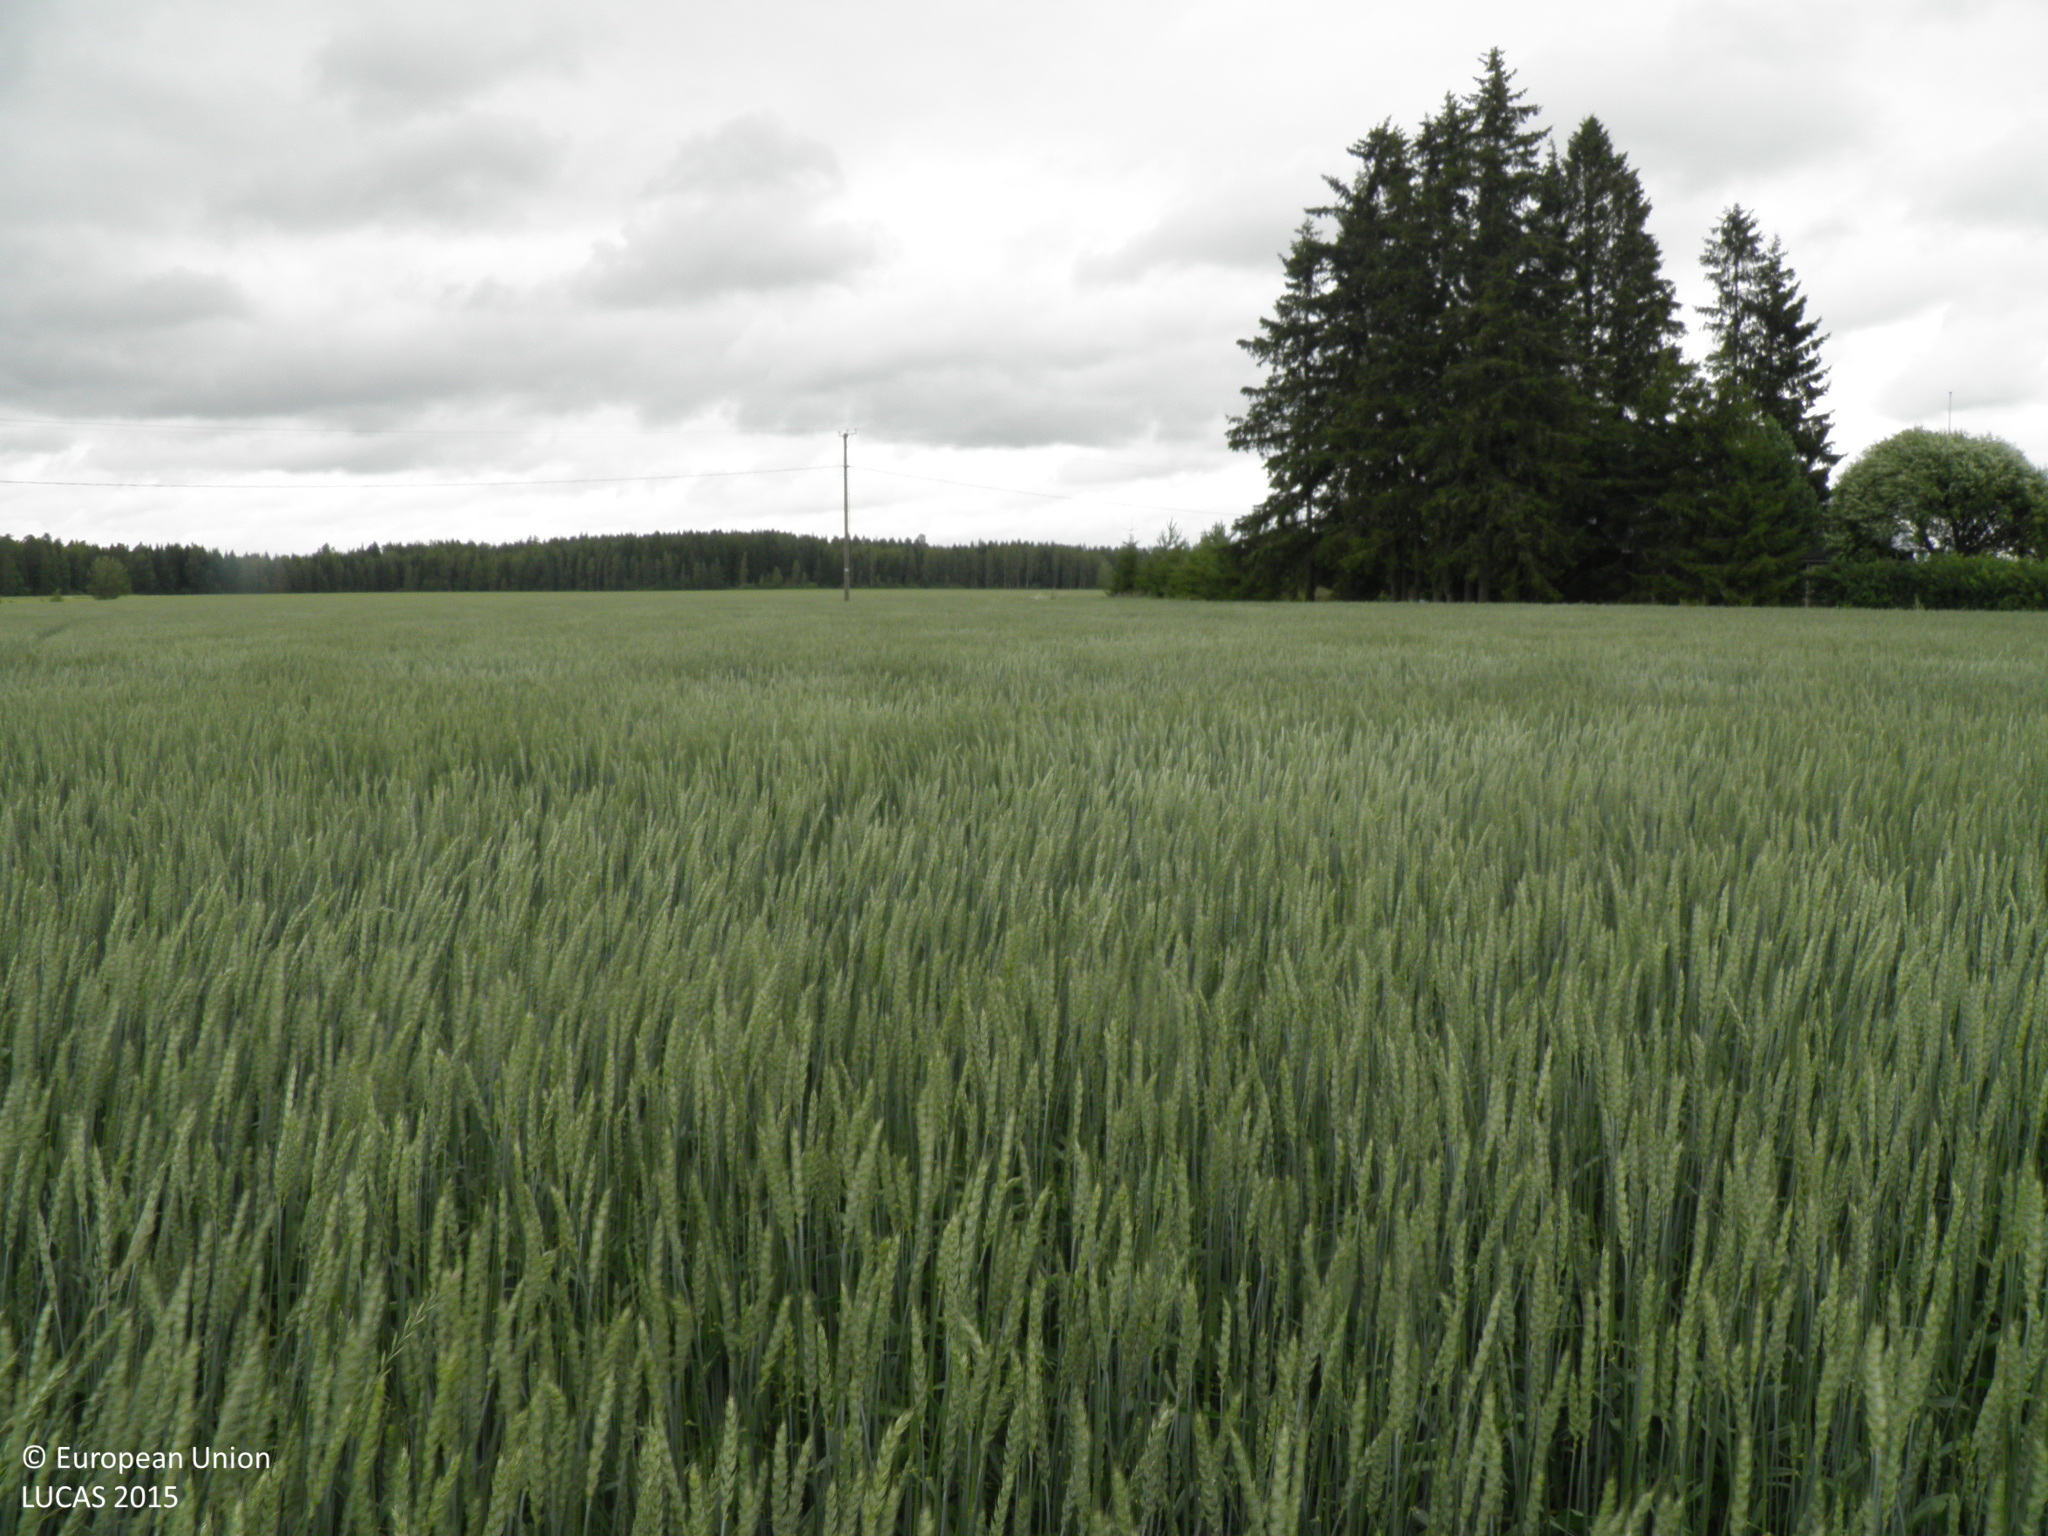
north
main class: Cropland
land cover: Common wheat
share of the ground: > 75 %
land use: Agriculture (excluding fallow land and kitchen gardens)
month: July
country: FI
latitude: 60.9028
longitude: 22.8855
